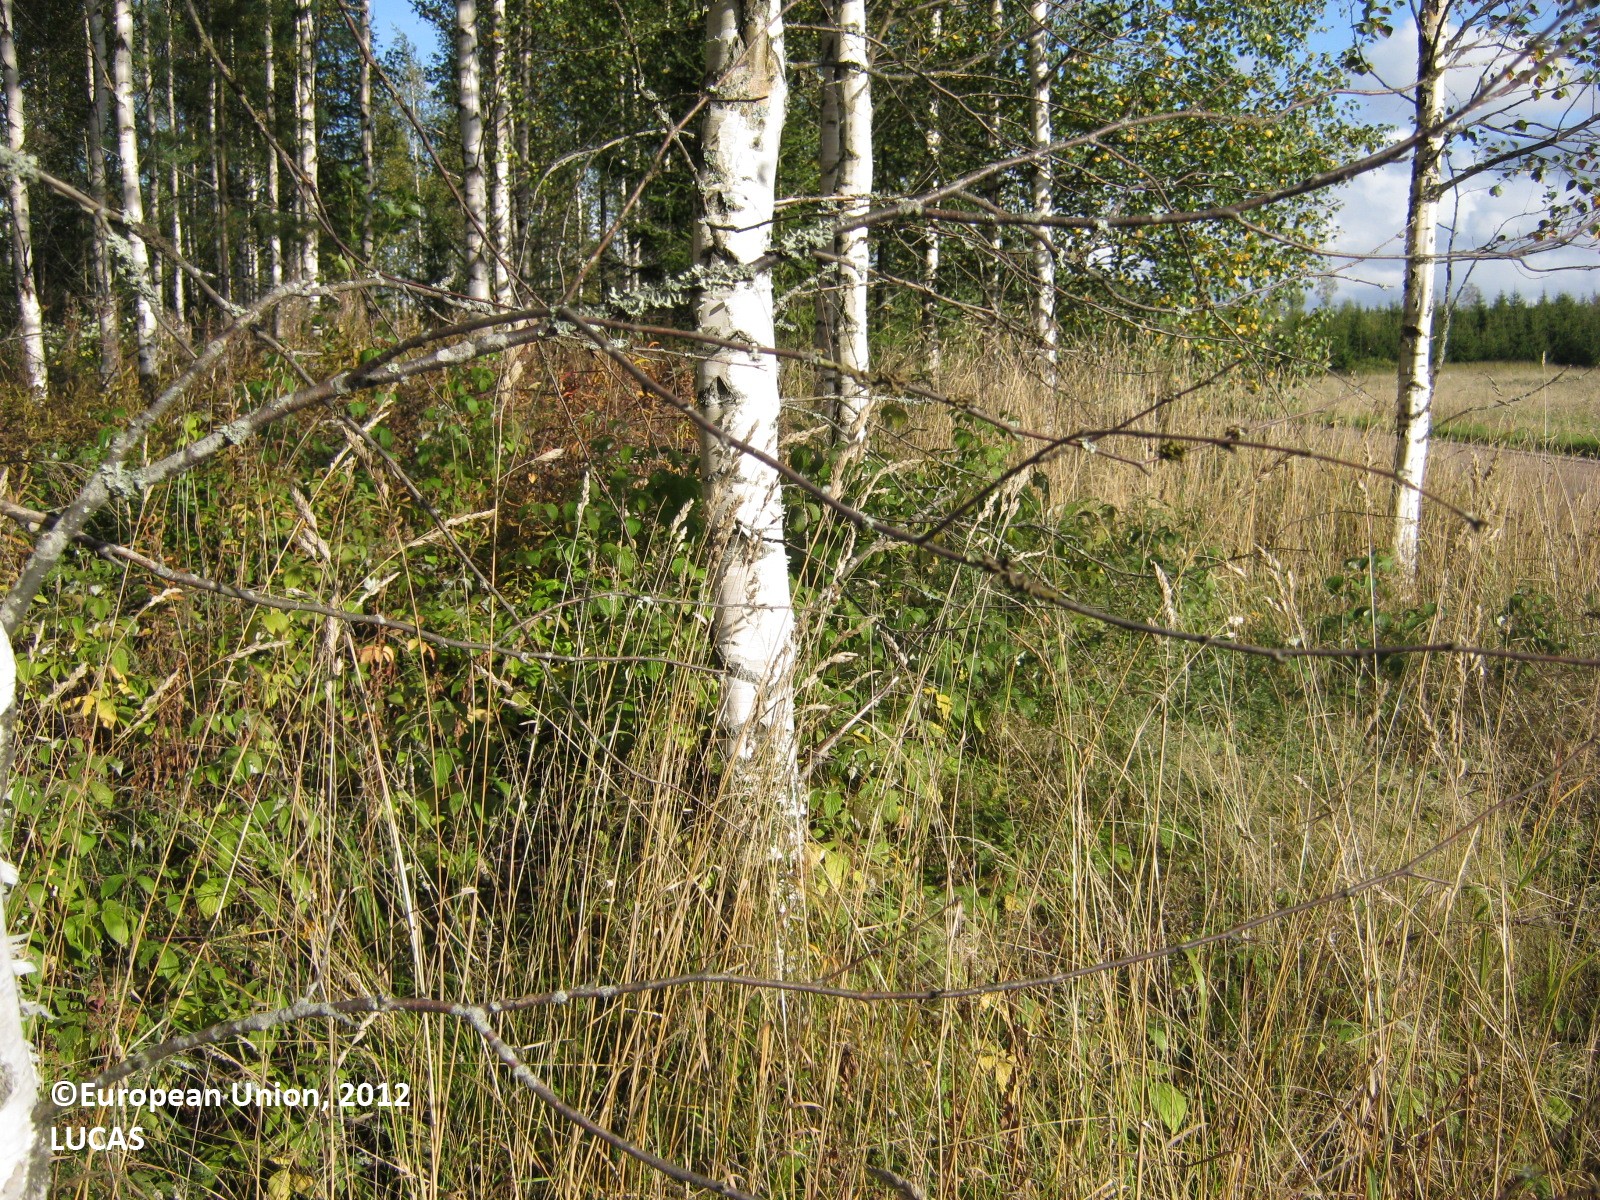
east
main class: Woodland
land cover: Broadleaved woodland
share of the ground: > 75 %
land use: Forestry
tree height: > 5 m
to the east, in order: Broadleaved woodland; Grass margins; Tracks; Grass margins; Ditches and canals; Broadleaved woodland; Inland water bodies; Broadleaved woodland; Inland water bodies; Broadleaved woodland; Inland marshes; Spruce dominated coniferous woodland
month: September
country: FI
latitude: 60.6665
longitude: 27.9317
